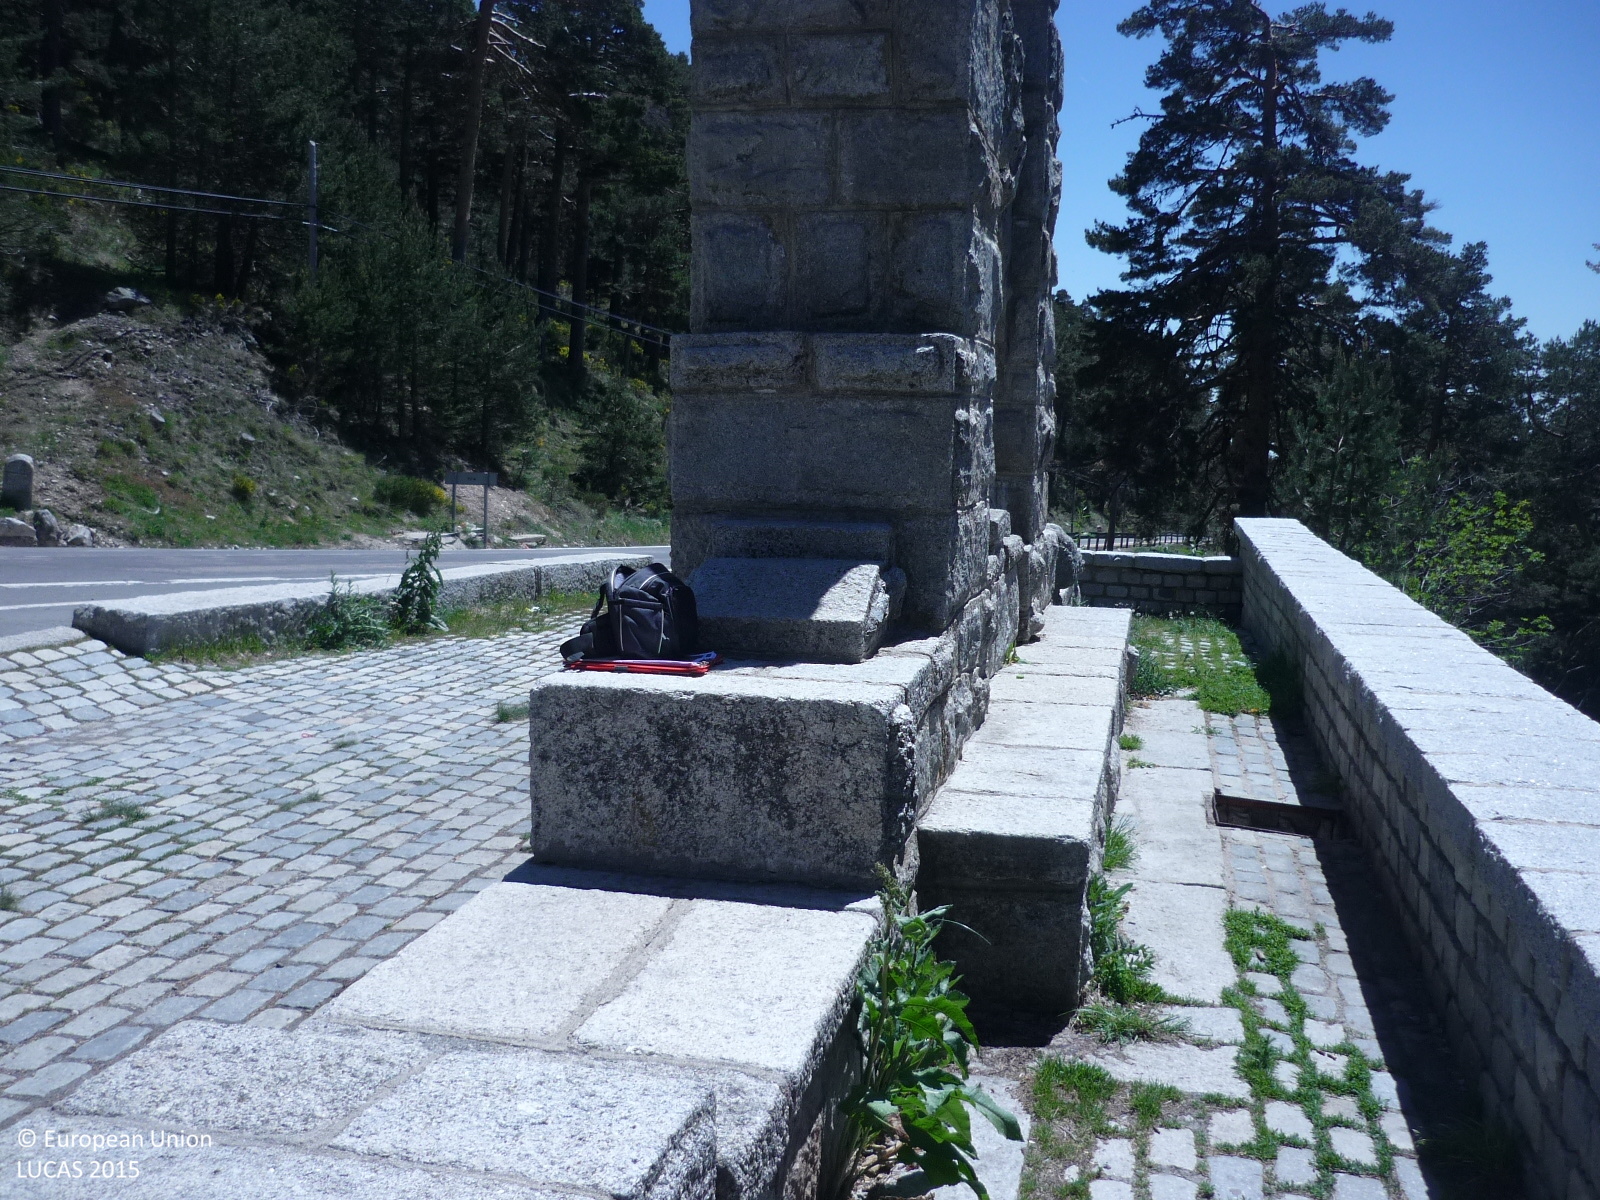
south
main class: Woodland
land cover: Pine dominated coniferous woodland
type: coniferous forest of the mediterranean region
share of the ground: > 75 %
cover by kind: coniferous forest trees 85 %, shrubs 10 %, herbaceous plants 5 %
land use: Forestry
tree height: > 5 m
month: May
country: ES
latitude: 40.7768
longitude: -4.0161
